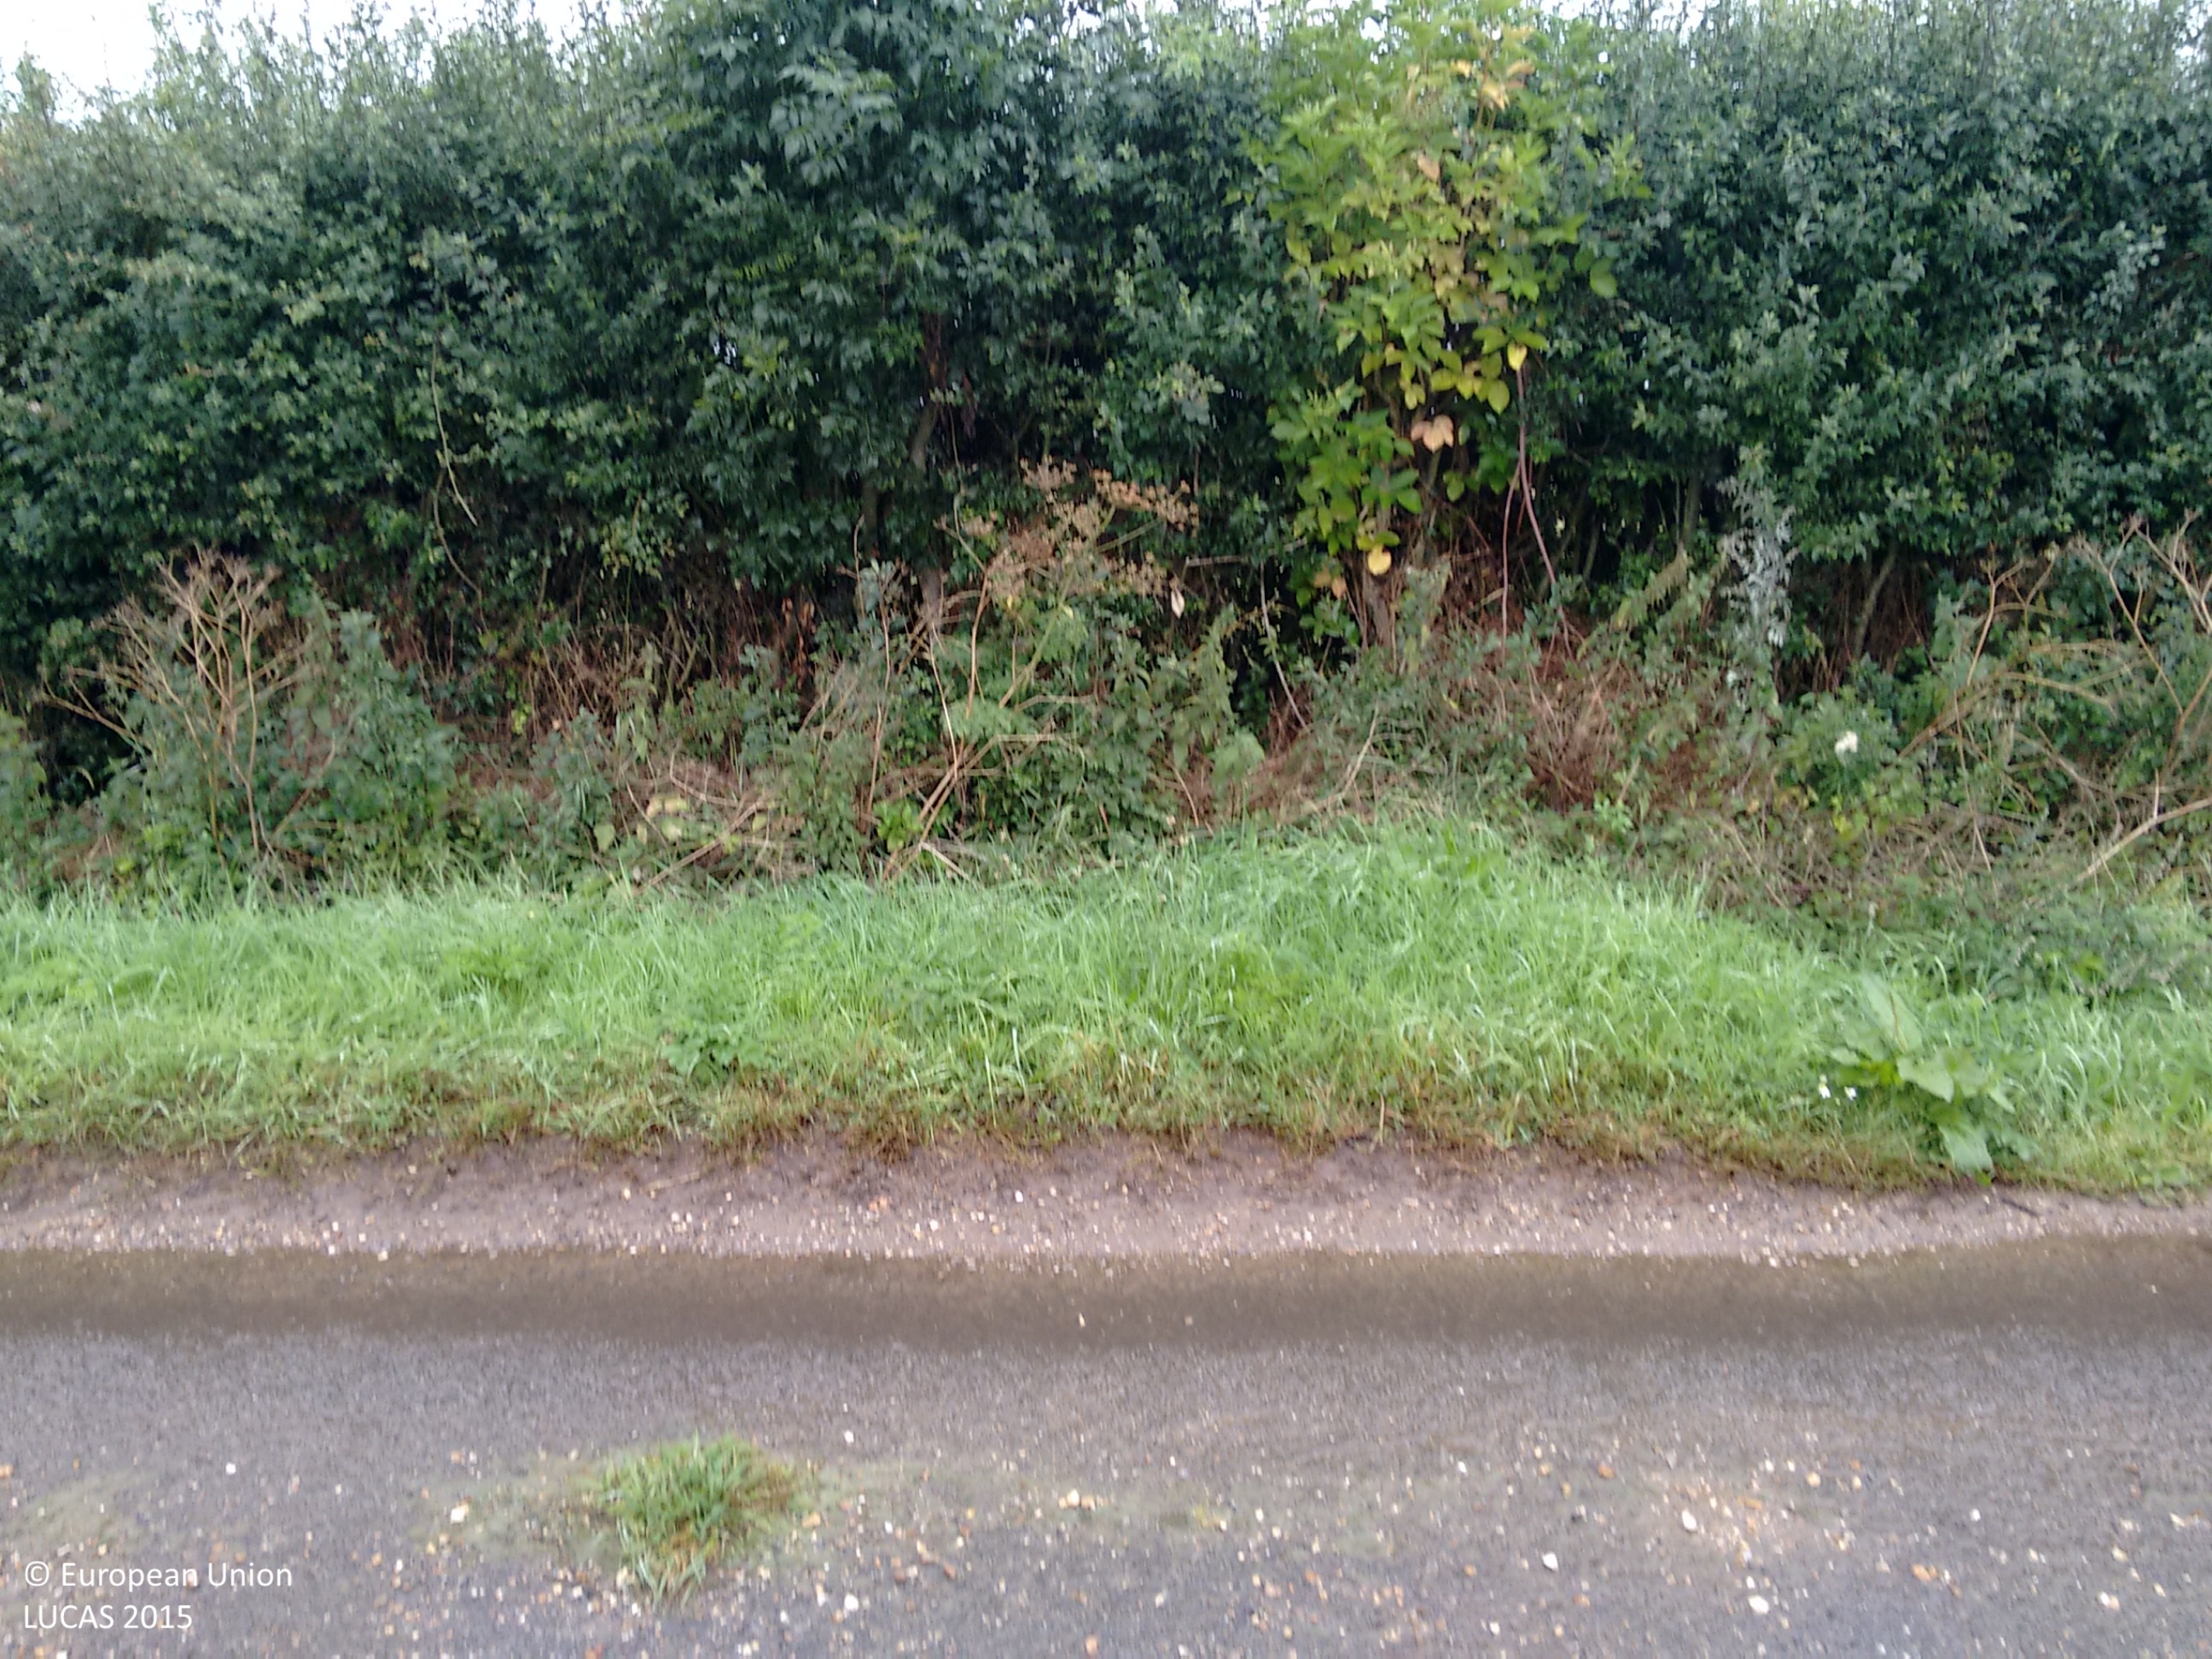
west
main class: Cropland
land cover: Common wheat
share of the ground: > 75 %
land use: Agriculture (excluding fallow land and kitchen gardens)
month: August
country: GB
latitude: 52.8152
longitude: 0.7911
